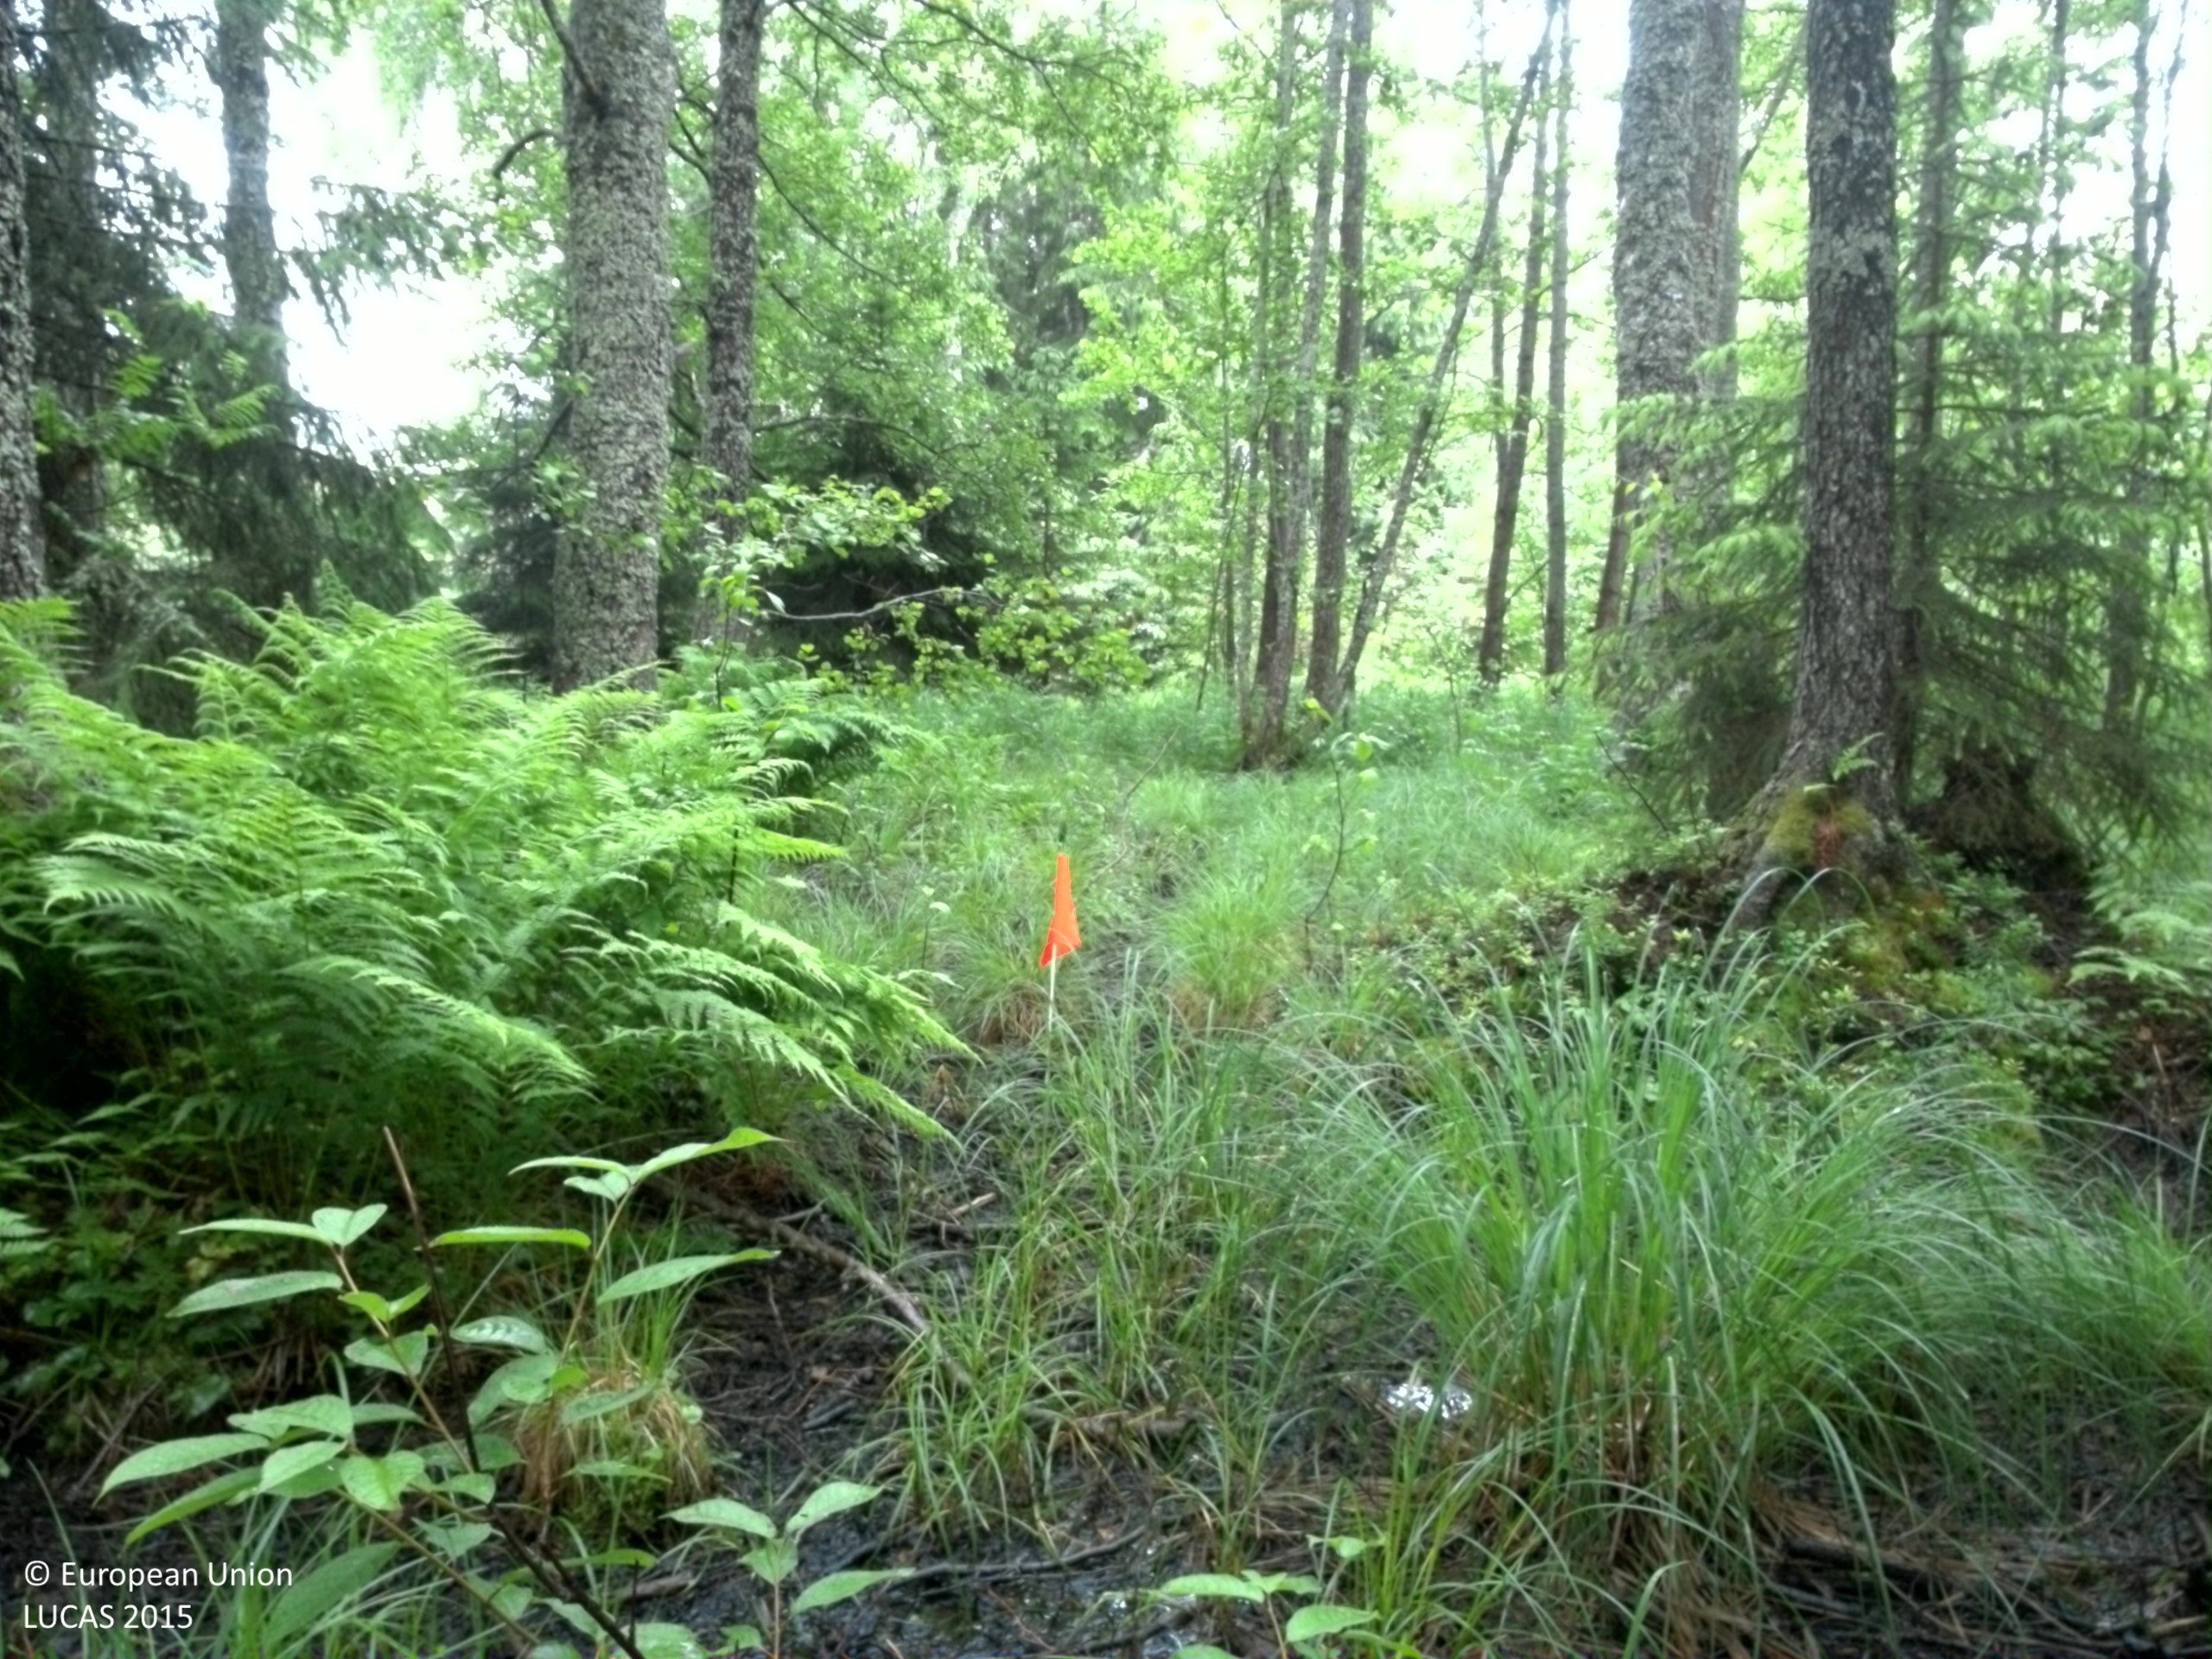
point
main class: Woodland
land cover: Broadleaved woodland
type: boreal forest
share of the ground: 50 - 75 %
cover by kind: broadleaved forest trees 50 %, herbaceous plants 25 %, coniferous forest trees 15 %, shrubs 5 %, lichens and mosses 5 %
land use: Forestry
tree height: > 5 m
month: June
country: SE
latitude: 60.4000
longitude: 18.1066
